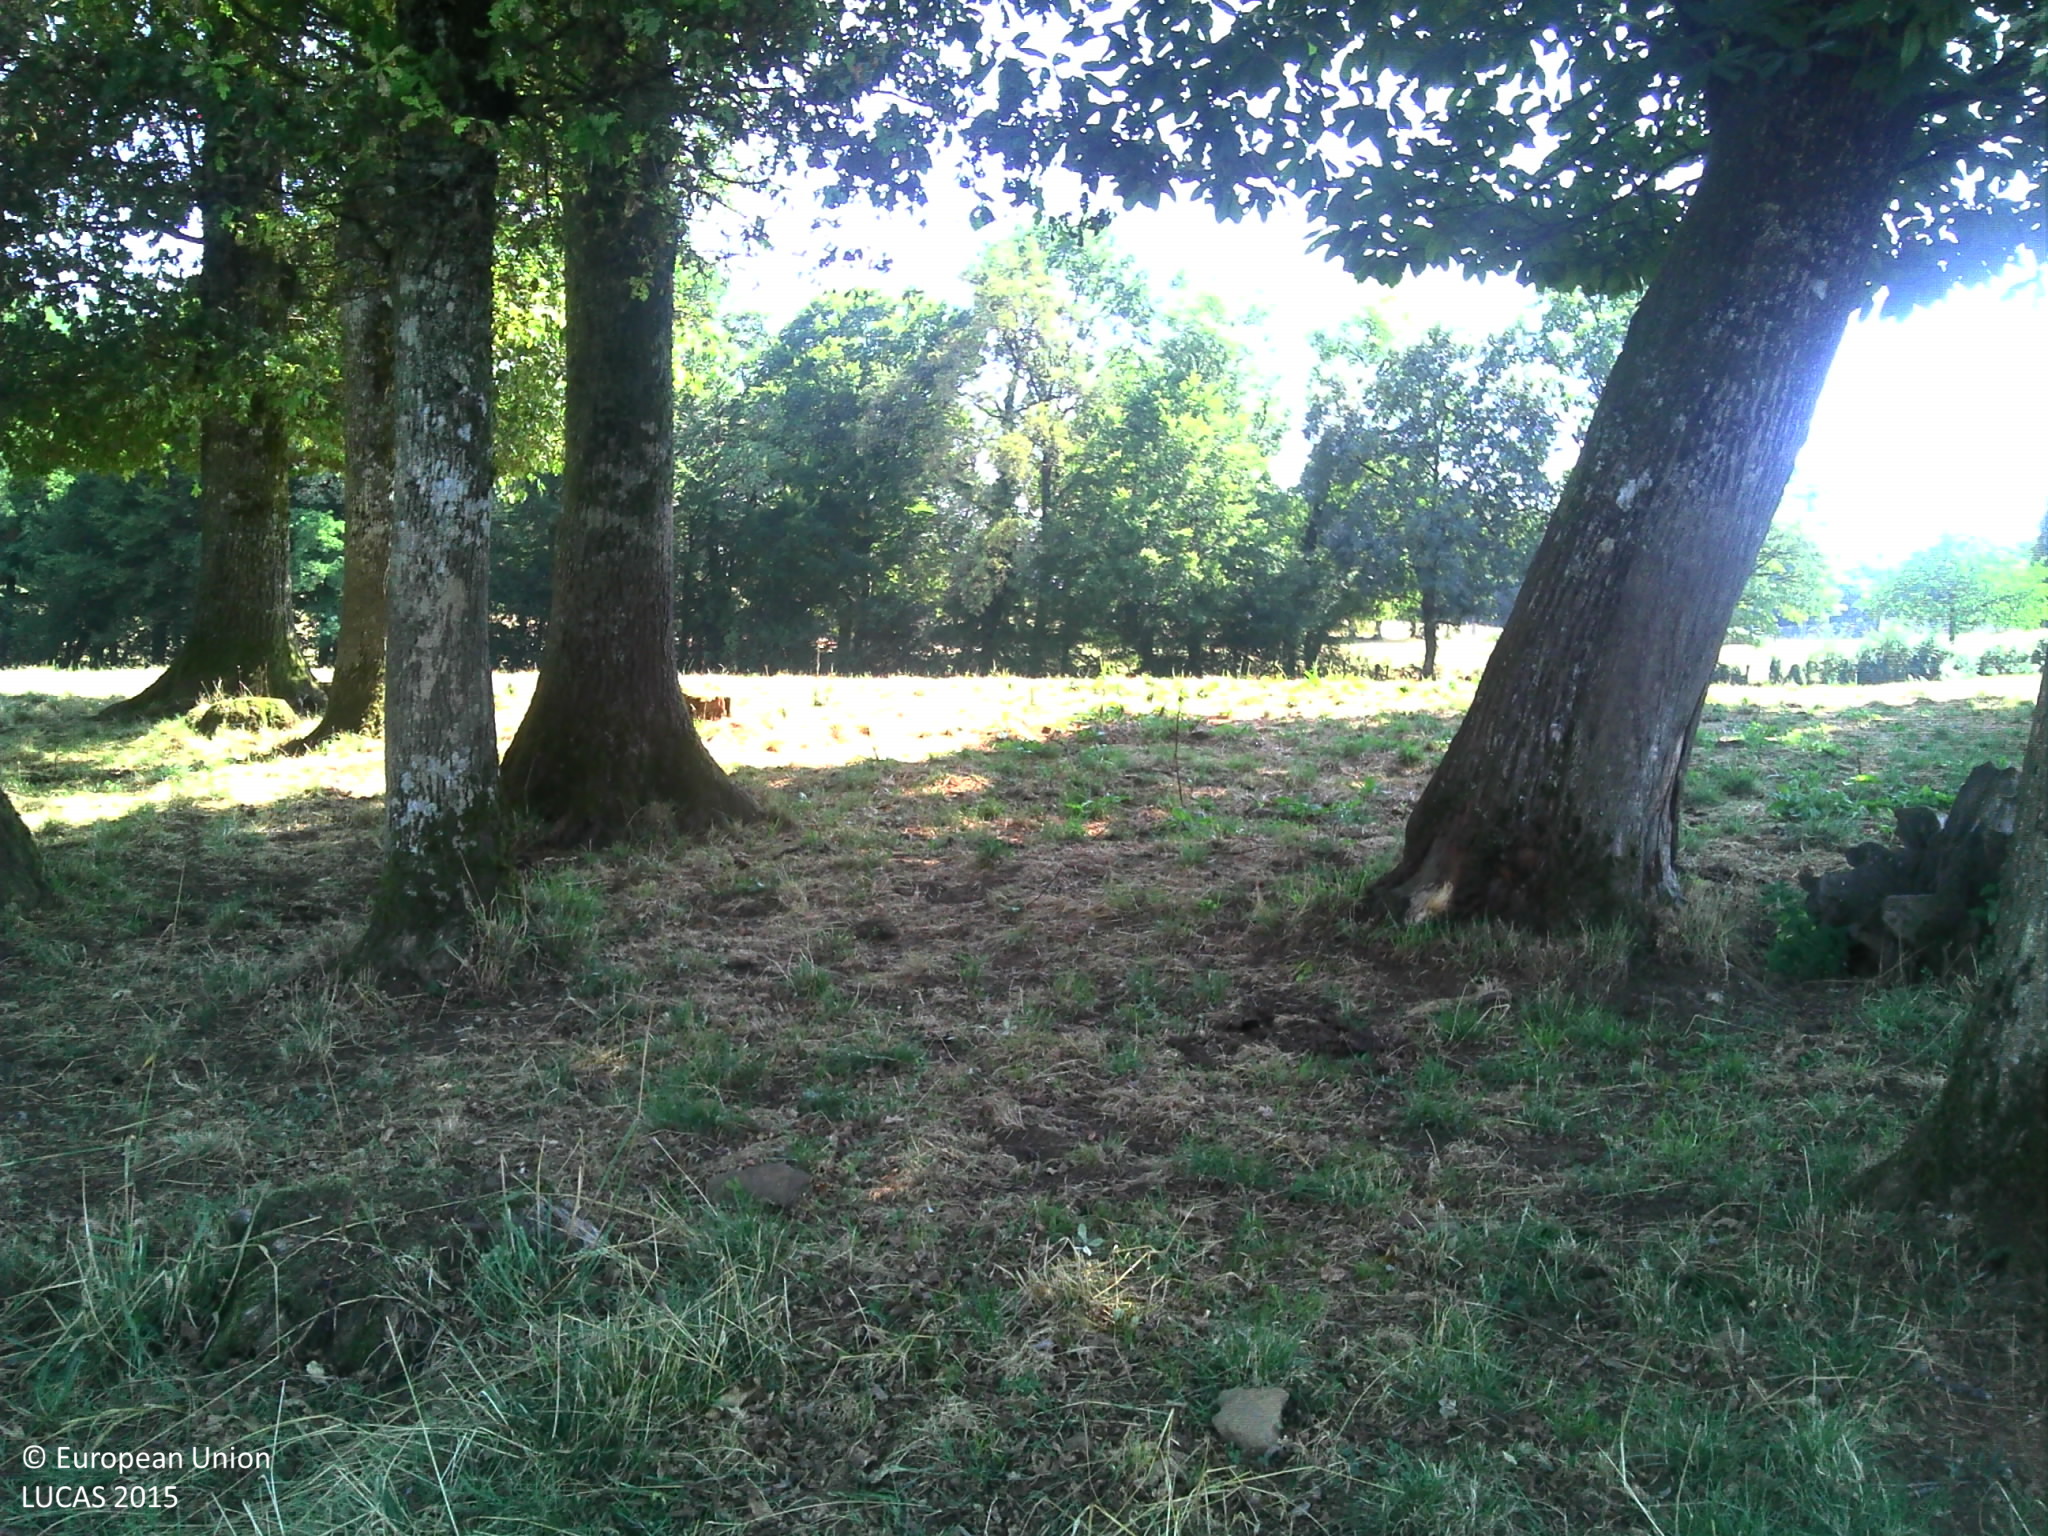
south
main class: Grassland
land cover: Grassland without tree/shrub cover
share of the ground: > 75 %
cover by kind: herbaceous plants 100 %
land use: Agriculture (excluding fallow land and kitchen gardens)
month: August
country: FR
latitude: 45.3750
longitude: 1.6823
